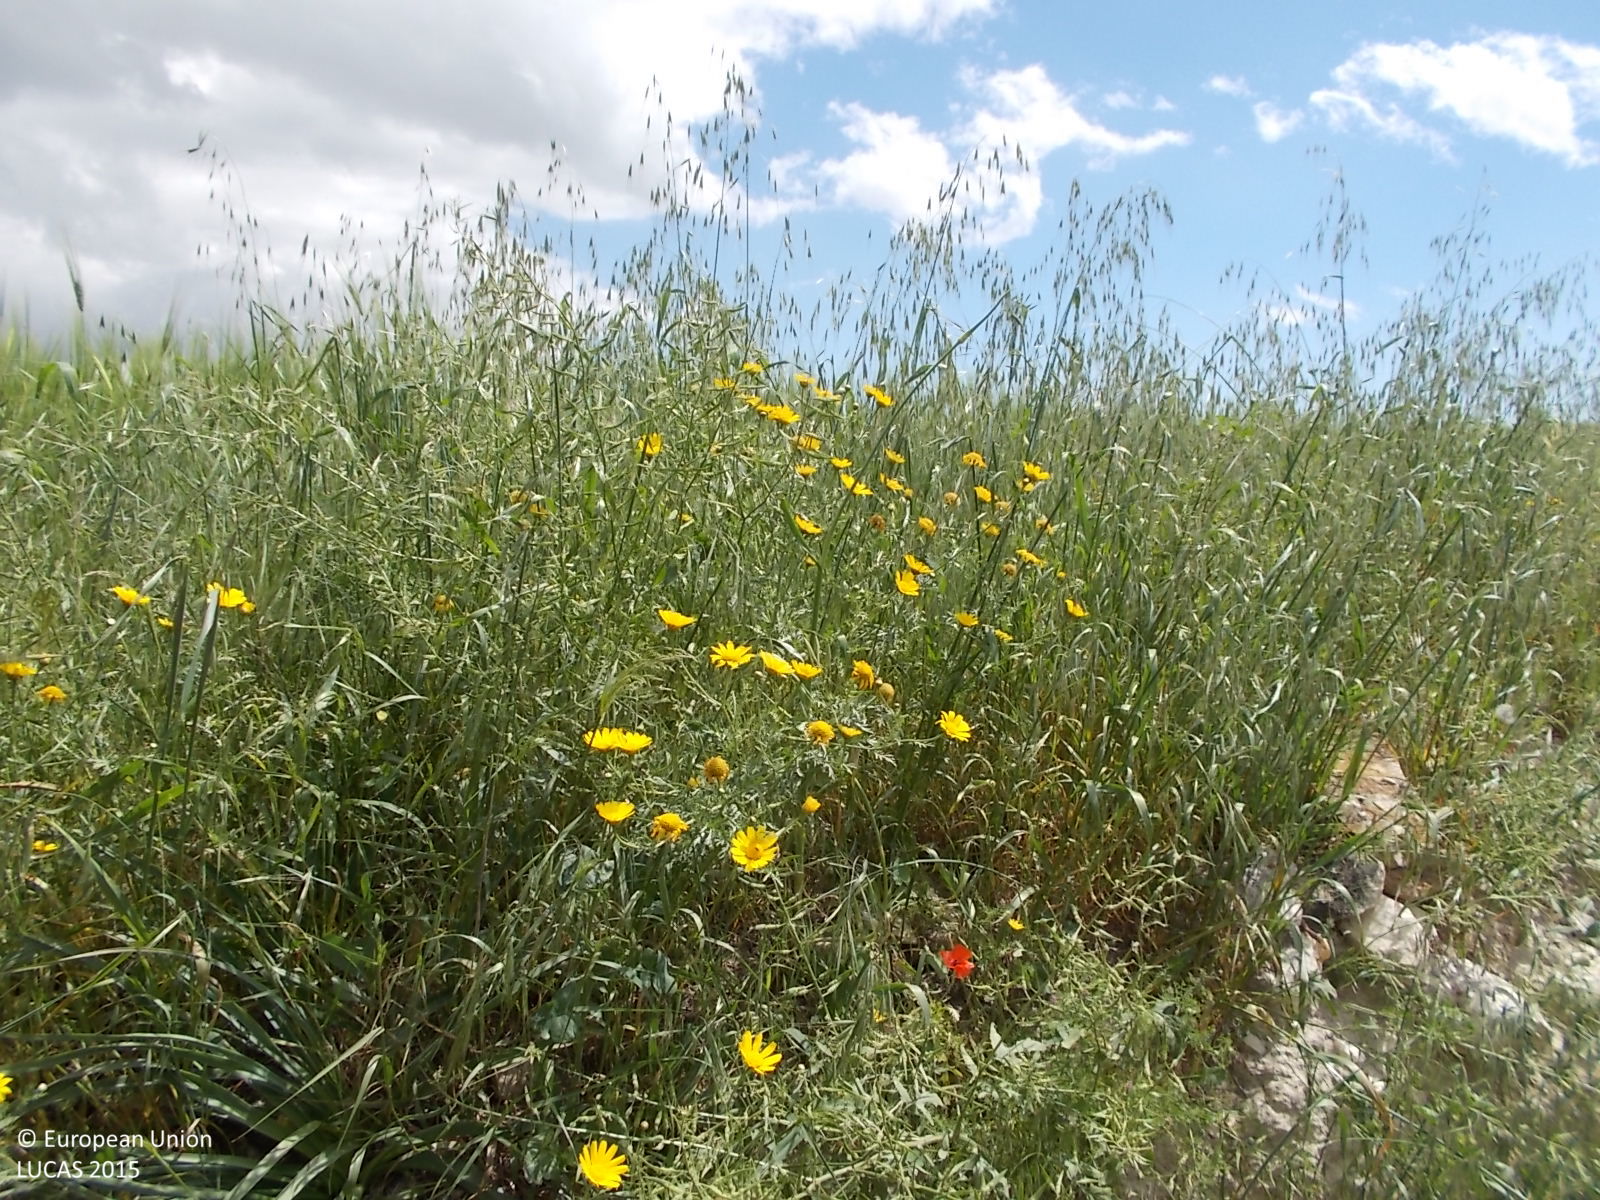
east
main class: Grassland
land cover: Grassland with sparse tree/shrub cover
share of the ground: > 75 %
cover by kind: herbaceous plants 80 %, unconsolidated bare surface 15 %, broadleaved forest trees 5 %
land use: Abandoned areas
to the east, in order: Grassland with sparse tree/shrub cover; Common wheat; Spontaneously vegetated surfaces; Rocks and stones; Barley; Rocks and stones; Shrubland without tree cover; Barley; Electric lines; Barley; Abandoned hedges; Barley
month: April
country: CY
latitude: 35.0317
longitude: 33.5323
